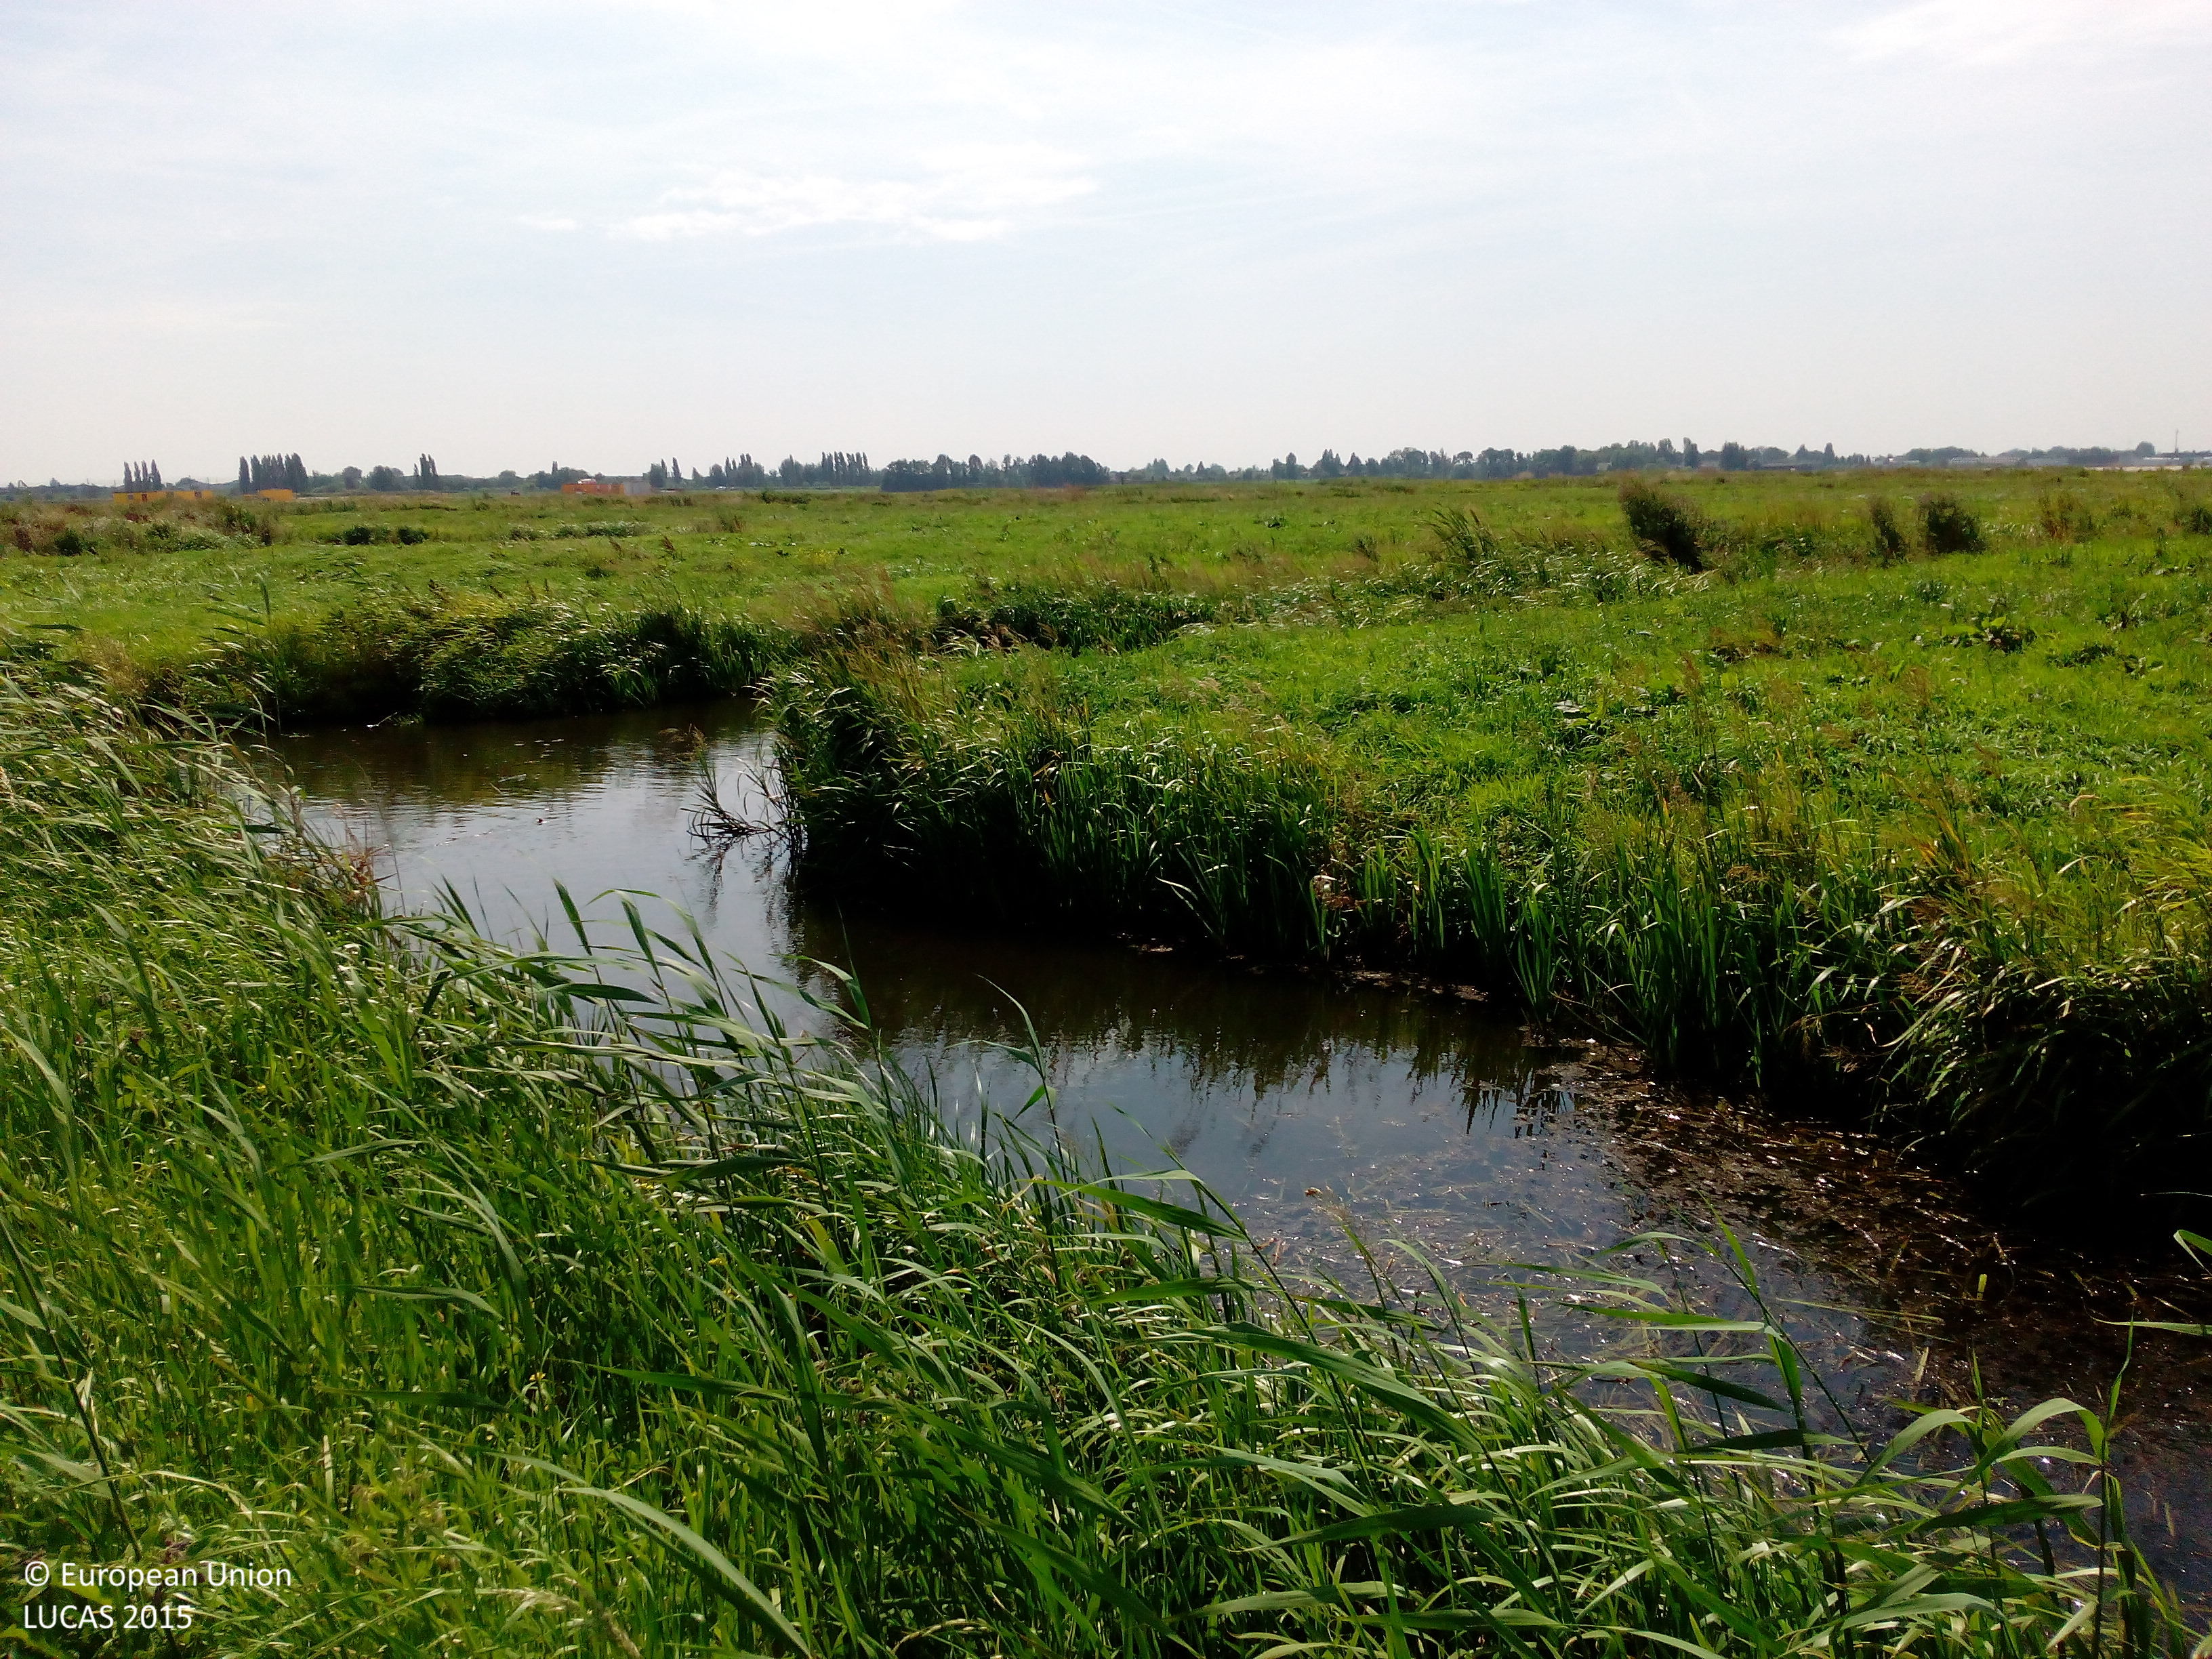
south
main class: Grassland
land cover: Grassland without tree/shrub cover
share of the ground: > 75 %
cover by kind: herbaceous plants 80 %, unconsolidated bare surface 20 %
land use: Agriculture (excluding fallow land and kitchen gardens)
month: August
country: NL
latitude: 52.0060
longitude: 4.6792
